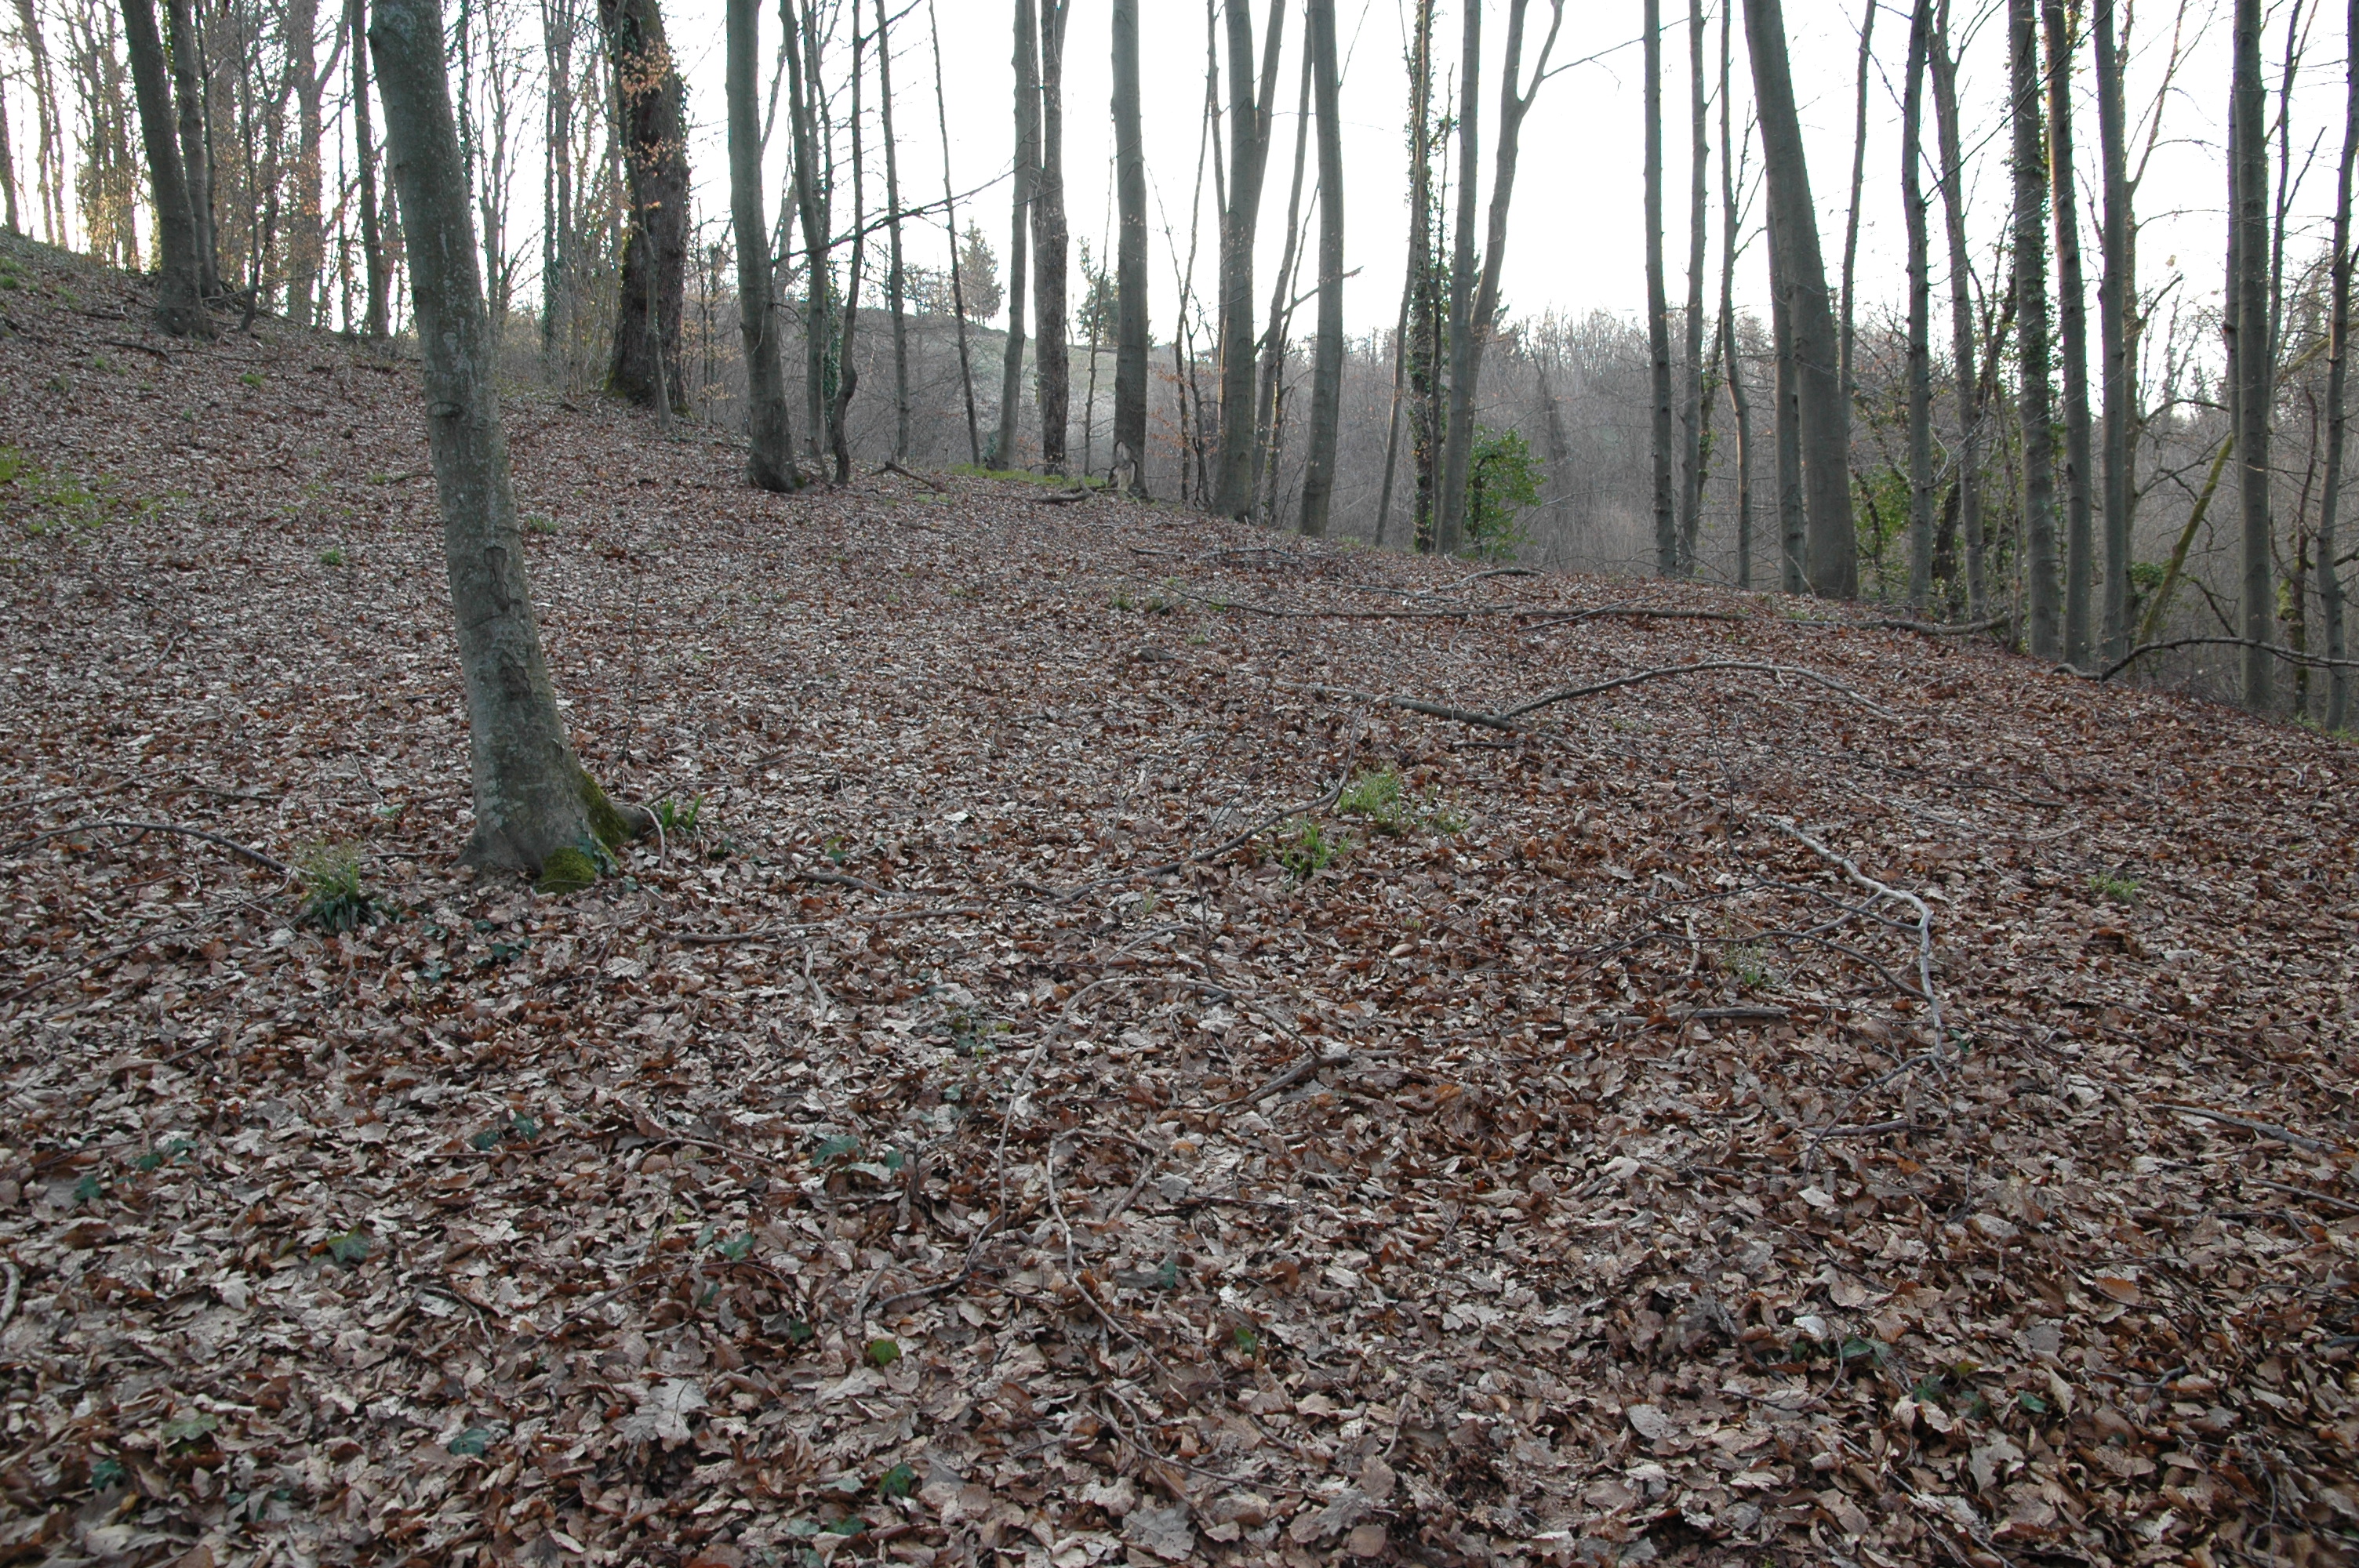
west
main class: Woodland
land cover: Broadleaved woodland
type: beech forest
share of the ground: > 75 %
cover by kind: broadleaved forest trees 90 %, shrubs 5 %, herbaceous plants 5 %
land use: Forestry
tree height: > 5 m
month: March
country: HR
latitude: 46.2397
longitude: 15.9515
